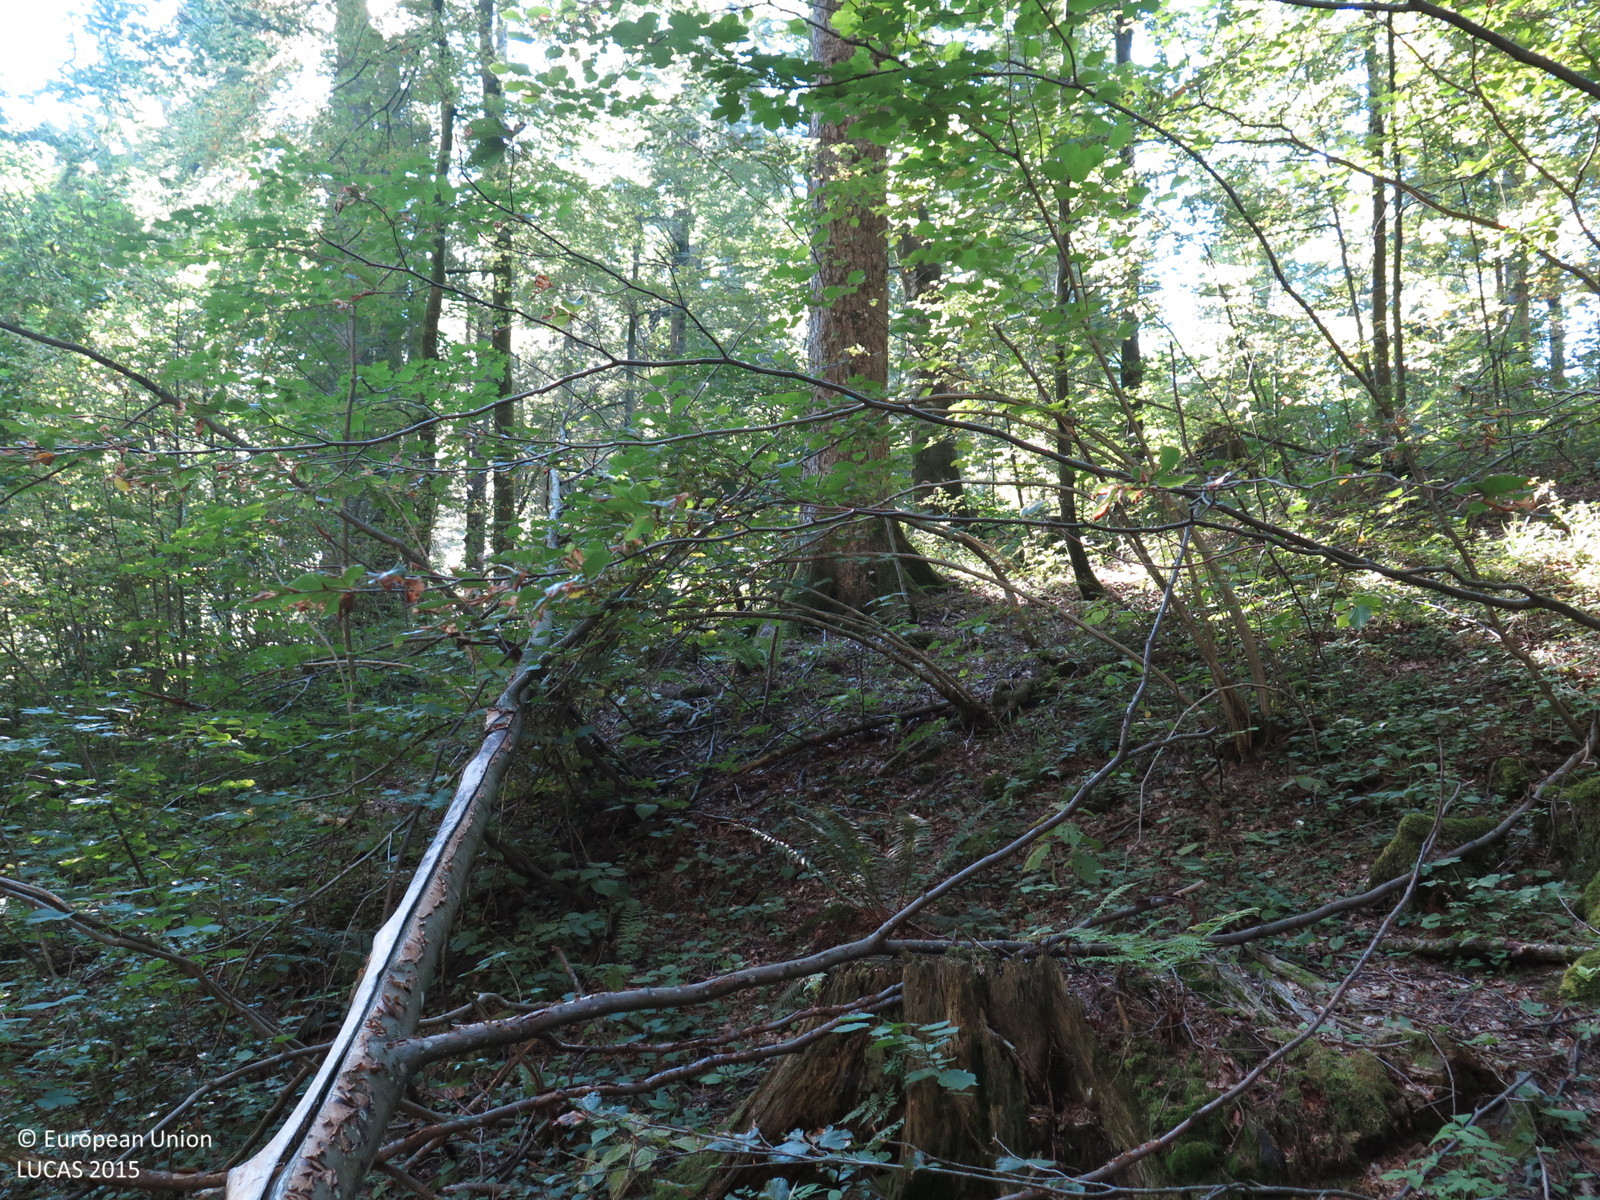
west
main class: Woodland
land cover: Broadleaved woodland
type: mountainous beech forest
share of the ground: > 75 %
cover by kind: broadleaved forest trees 80 %, coniferous forest trees 20 %
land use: Forestry
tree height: > 5 m
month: August
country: HR
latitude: 45.3397
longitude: 14.8317
